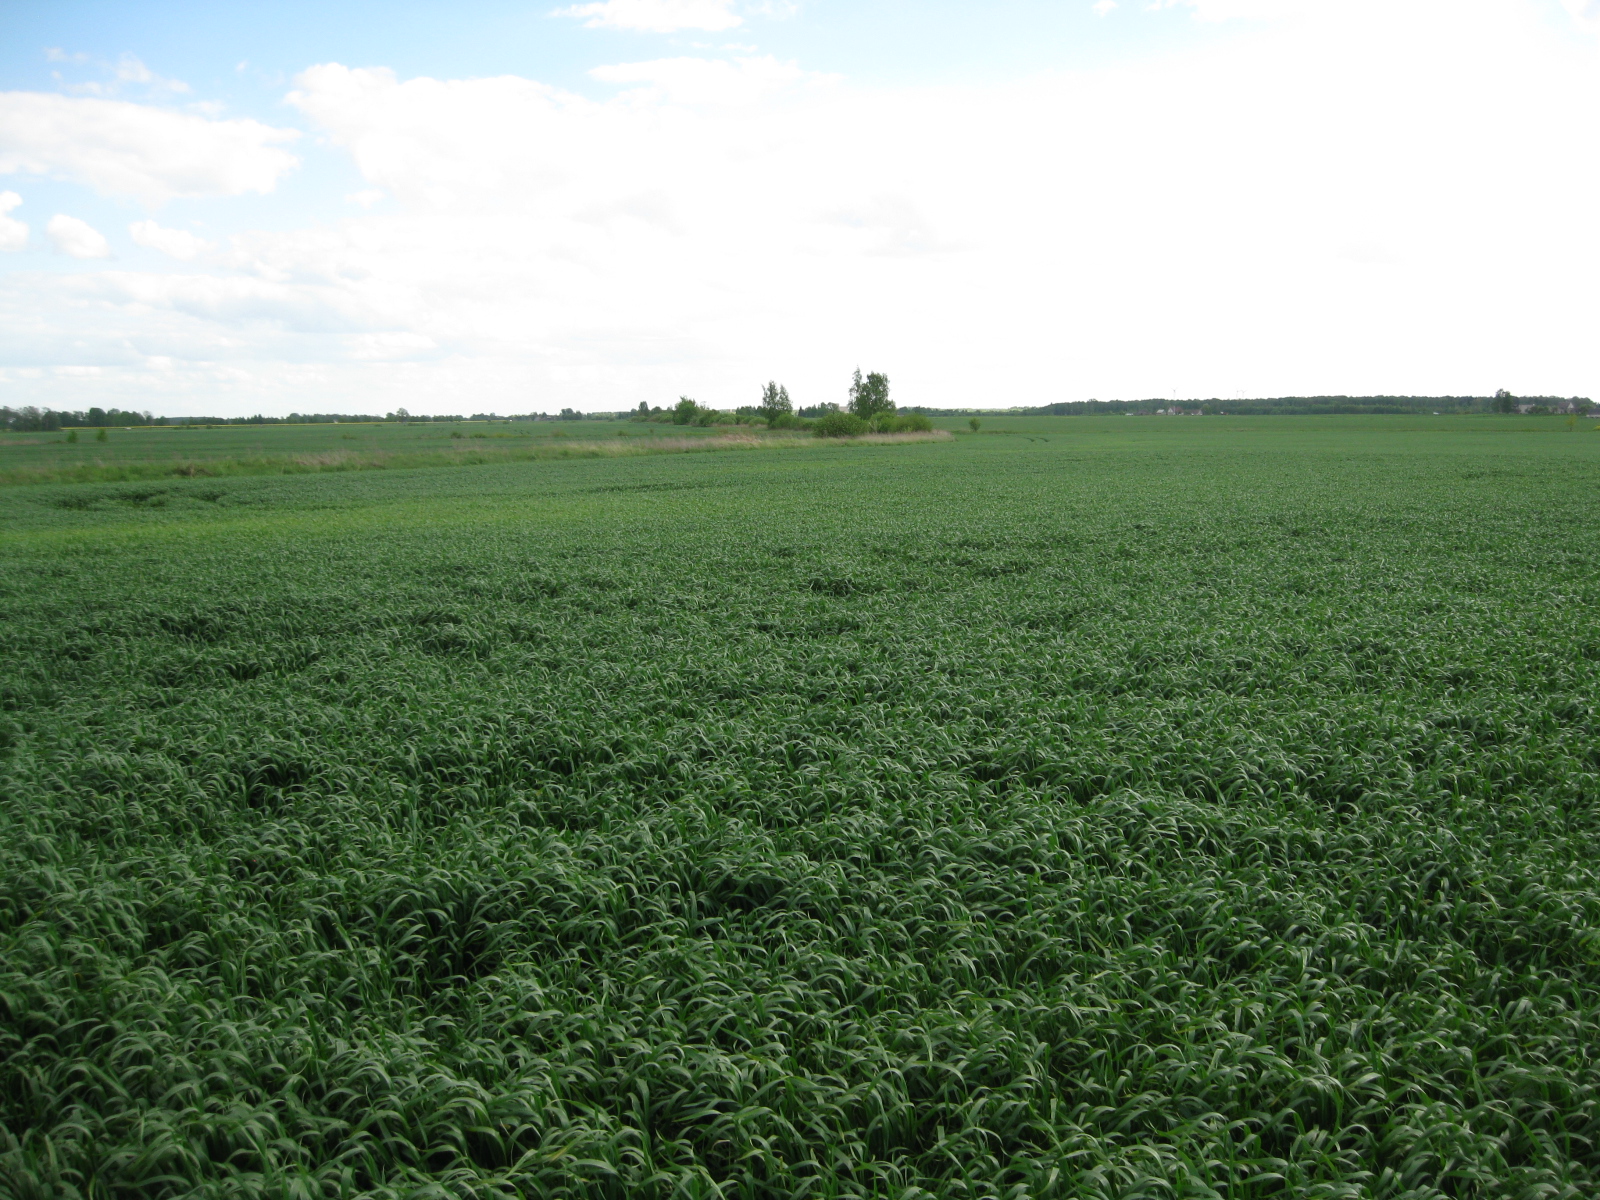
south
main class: Cropland
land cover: Common wheat
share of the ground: > 75 %
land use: Agriculture (excluding fallow land and kitchen gardens)
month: May
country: LT
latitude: 56.0609
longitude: 23.9457
